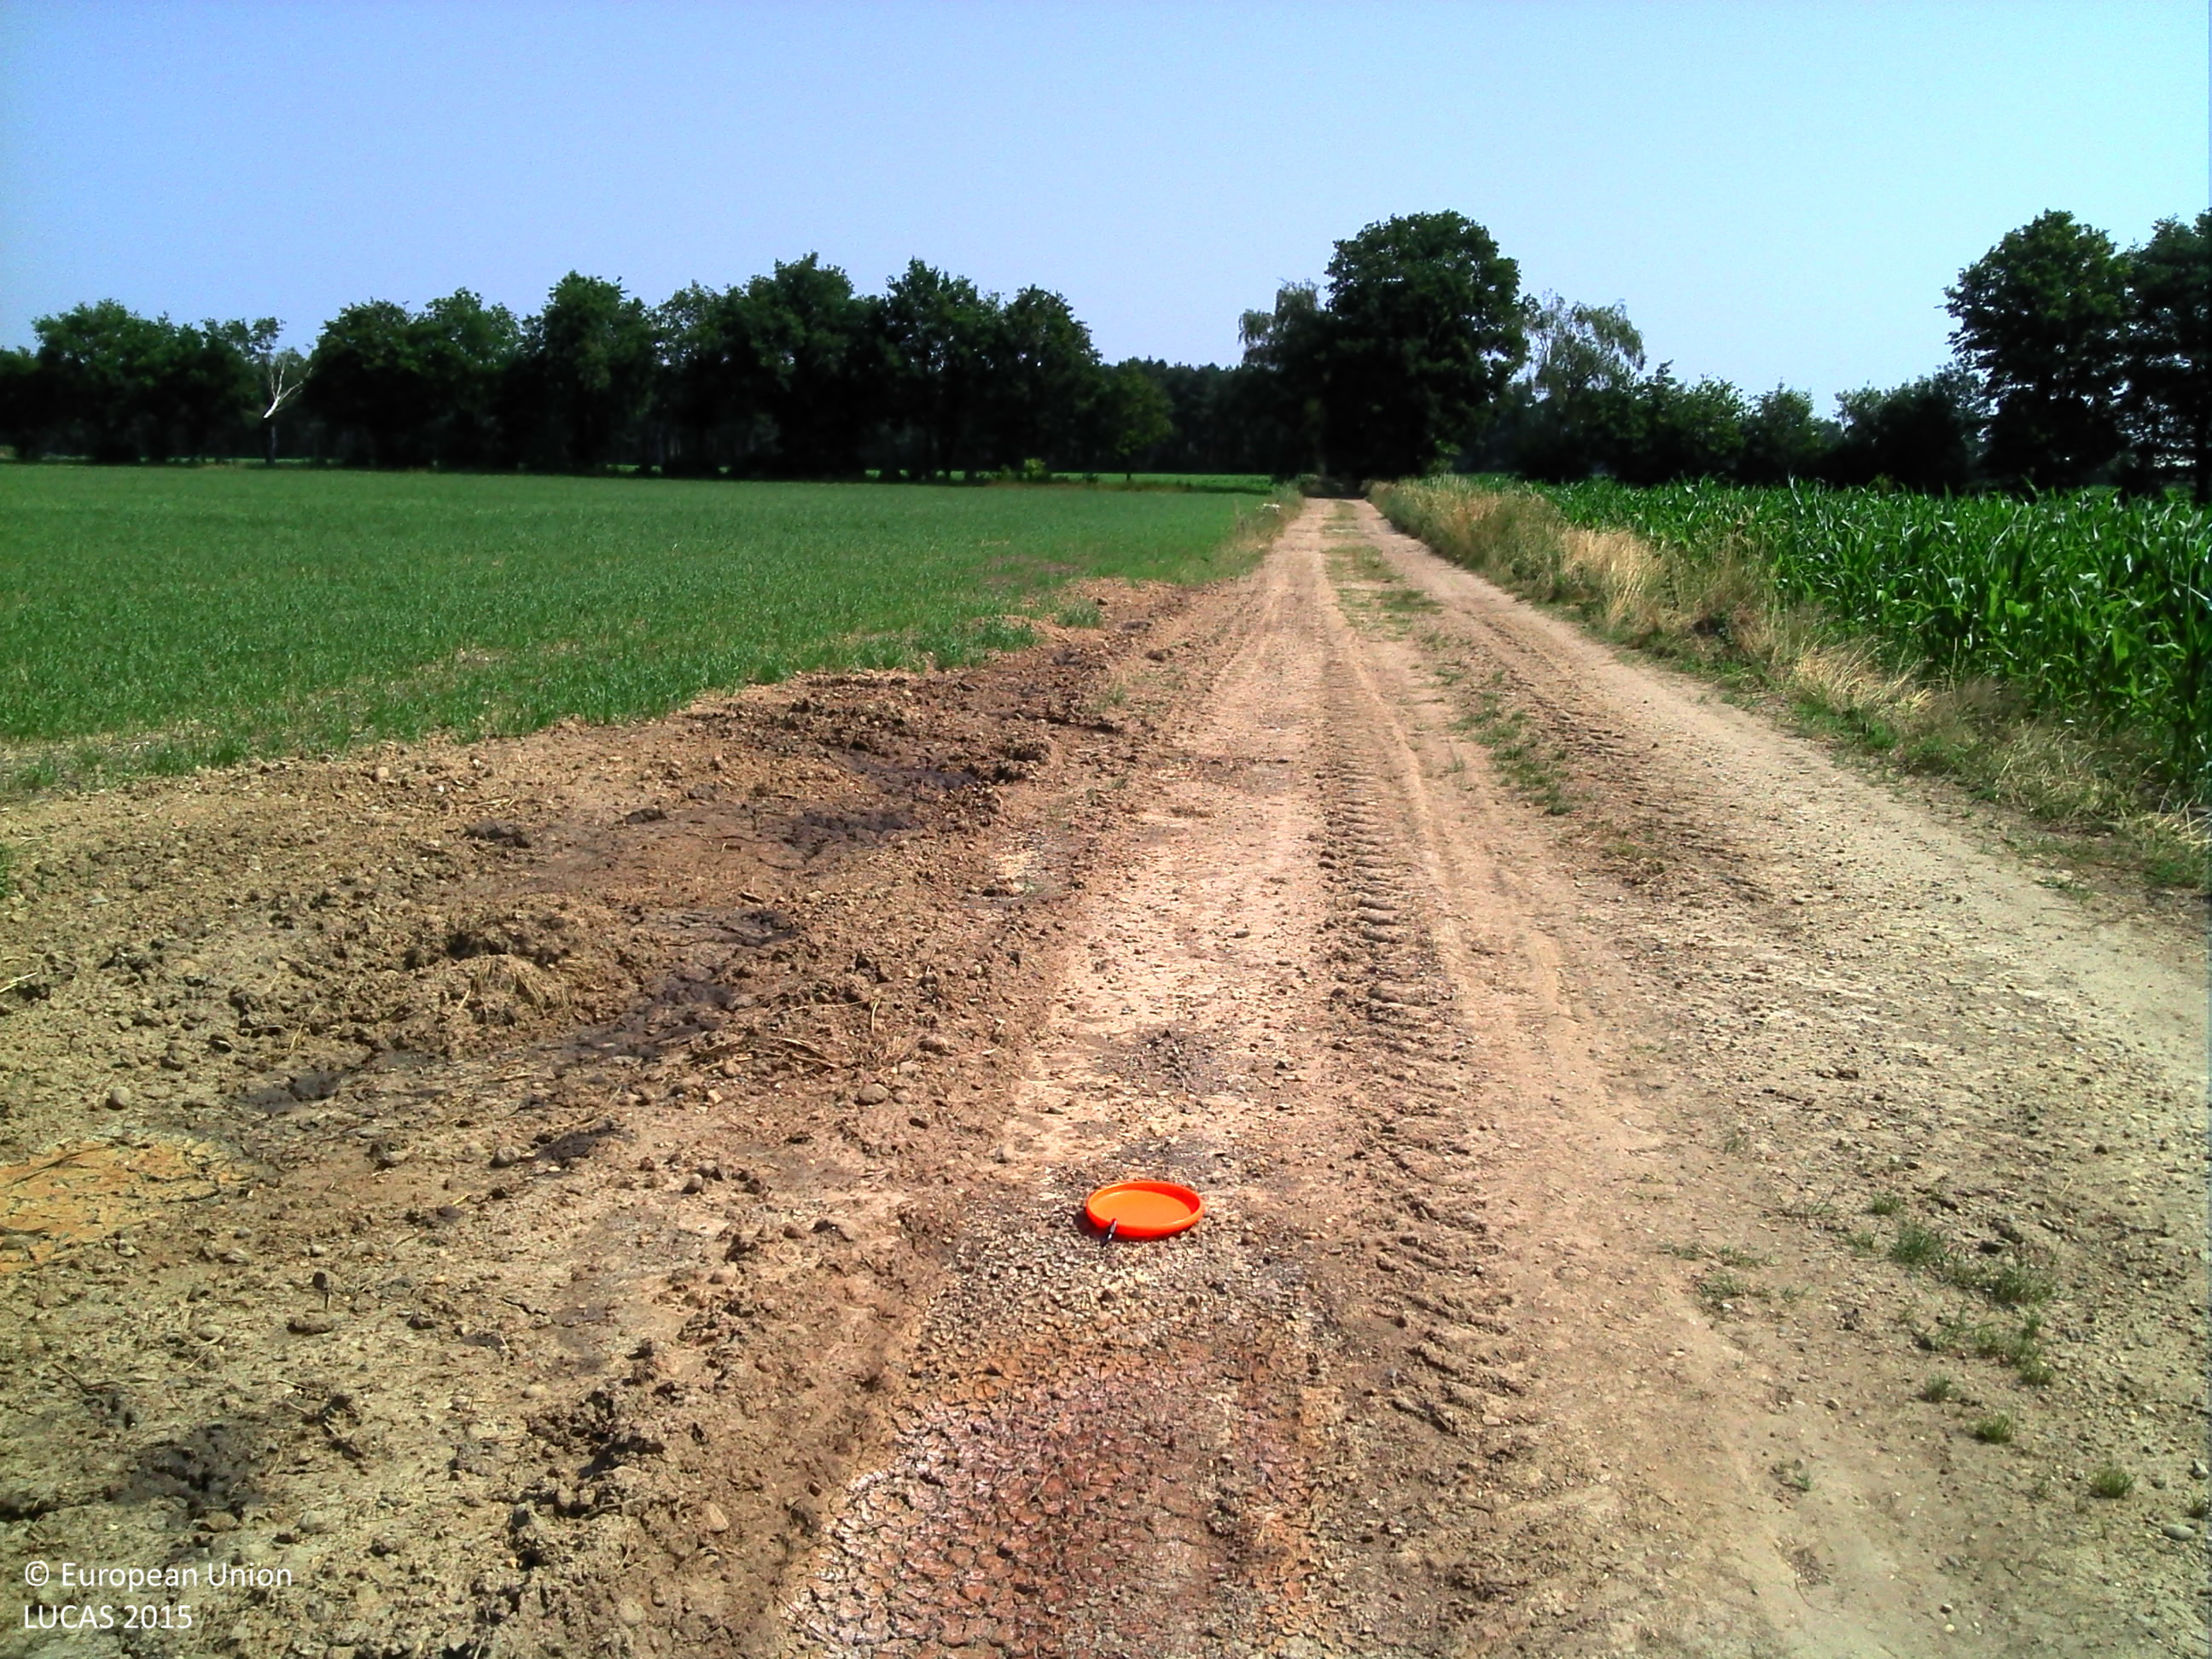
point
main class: Cropland
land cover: Maize
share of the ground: > 75 %
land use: Agriculture (excluding fallow land and kitchen gardens)
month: July
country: BE
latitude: 51.0826
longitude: 5.4157
